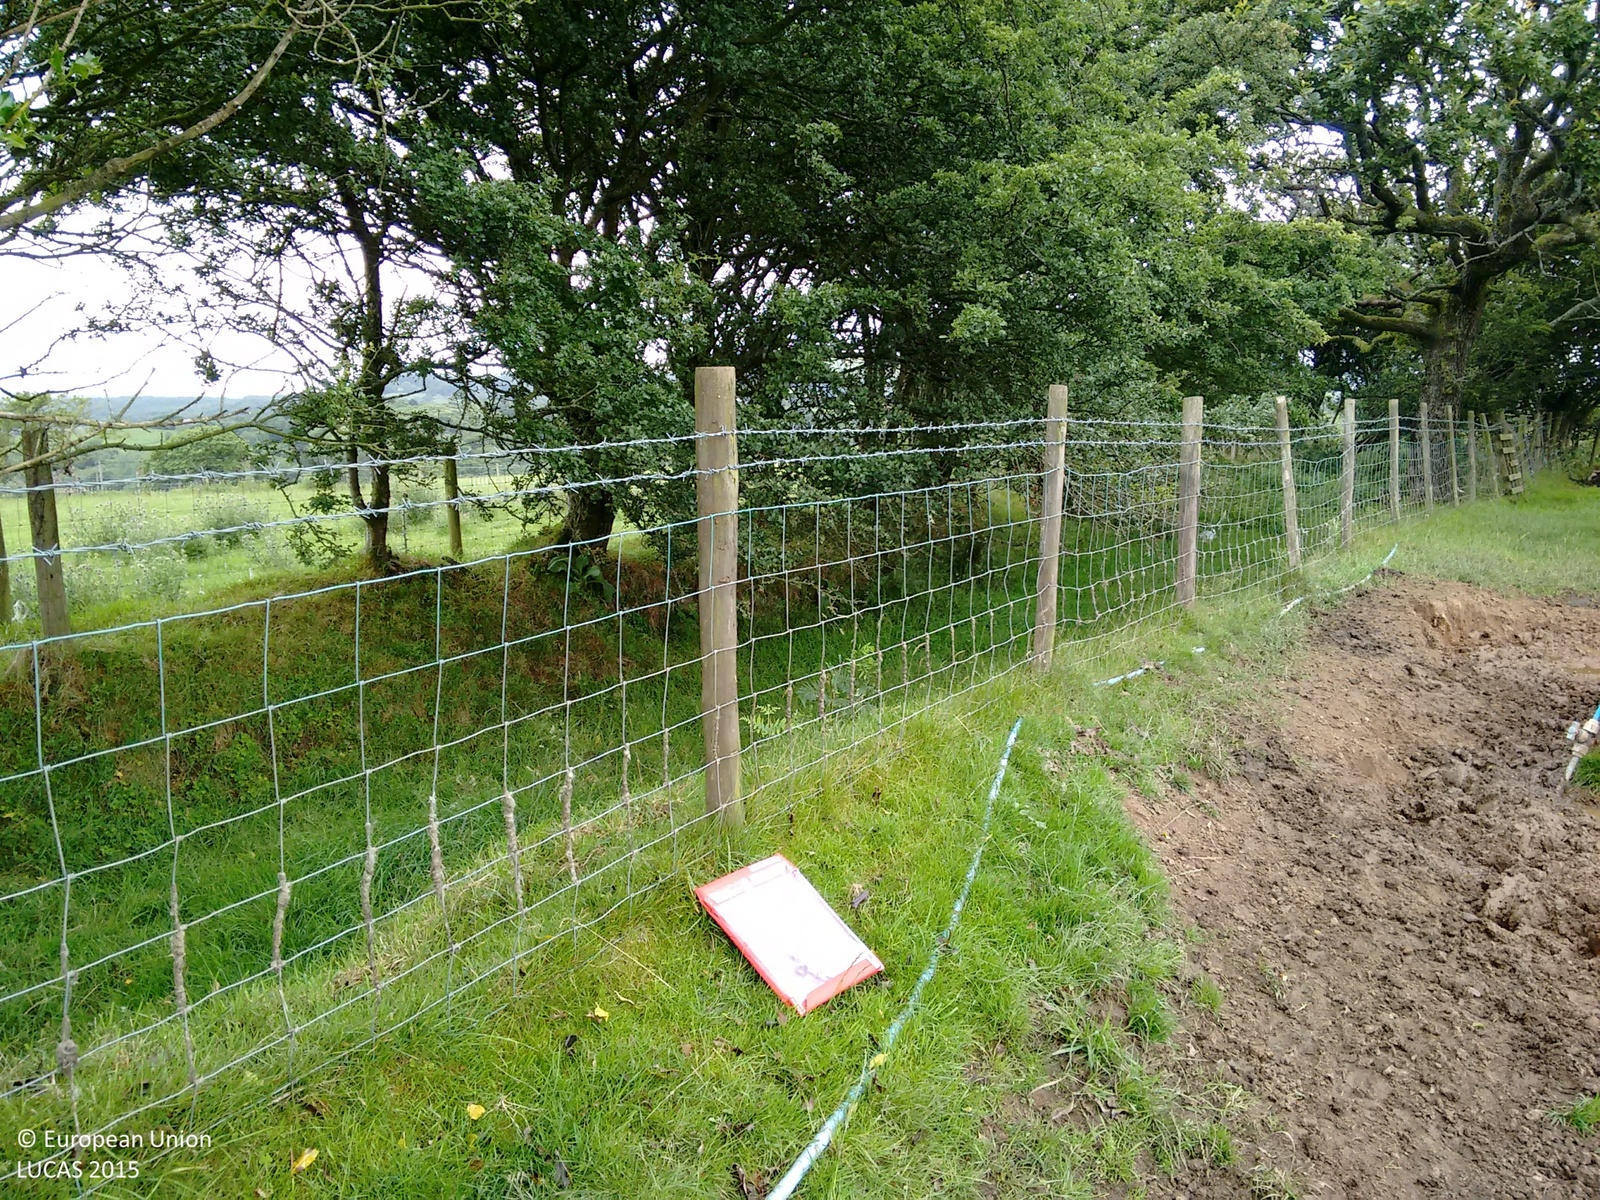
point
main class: Grassland
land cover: Grassland without tree/shrub cover
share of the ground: > 75 %
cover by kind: herbaceous plants 100 %
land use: Agriculture (excluding fallow land and kitchen gardens)
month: July
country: GB
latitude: 51.5568
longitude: -3.5718
